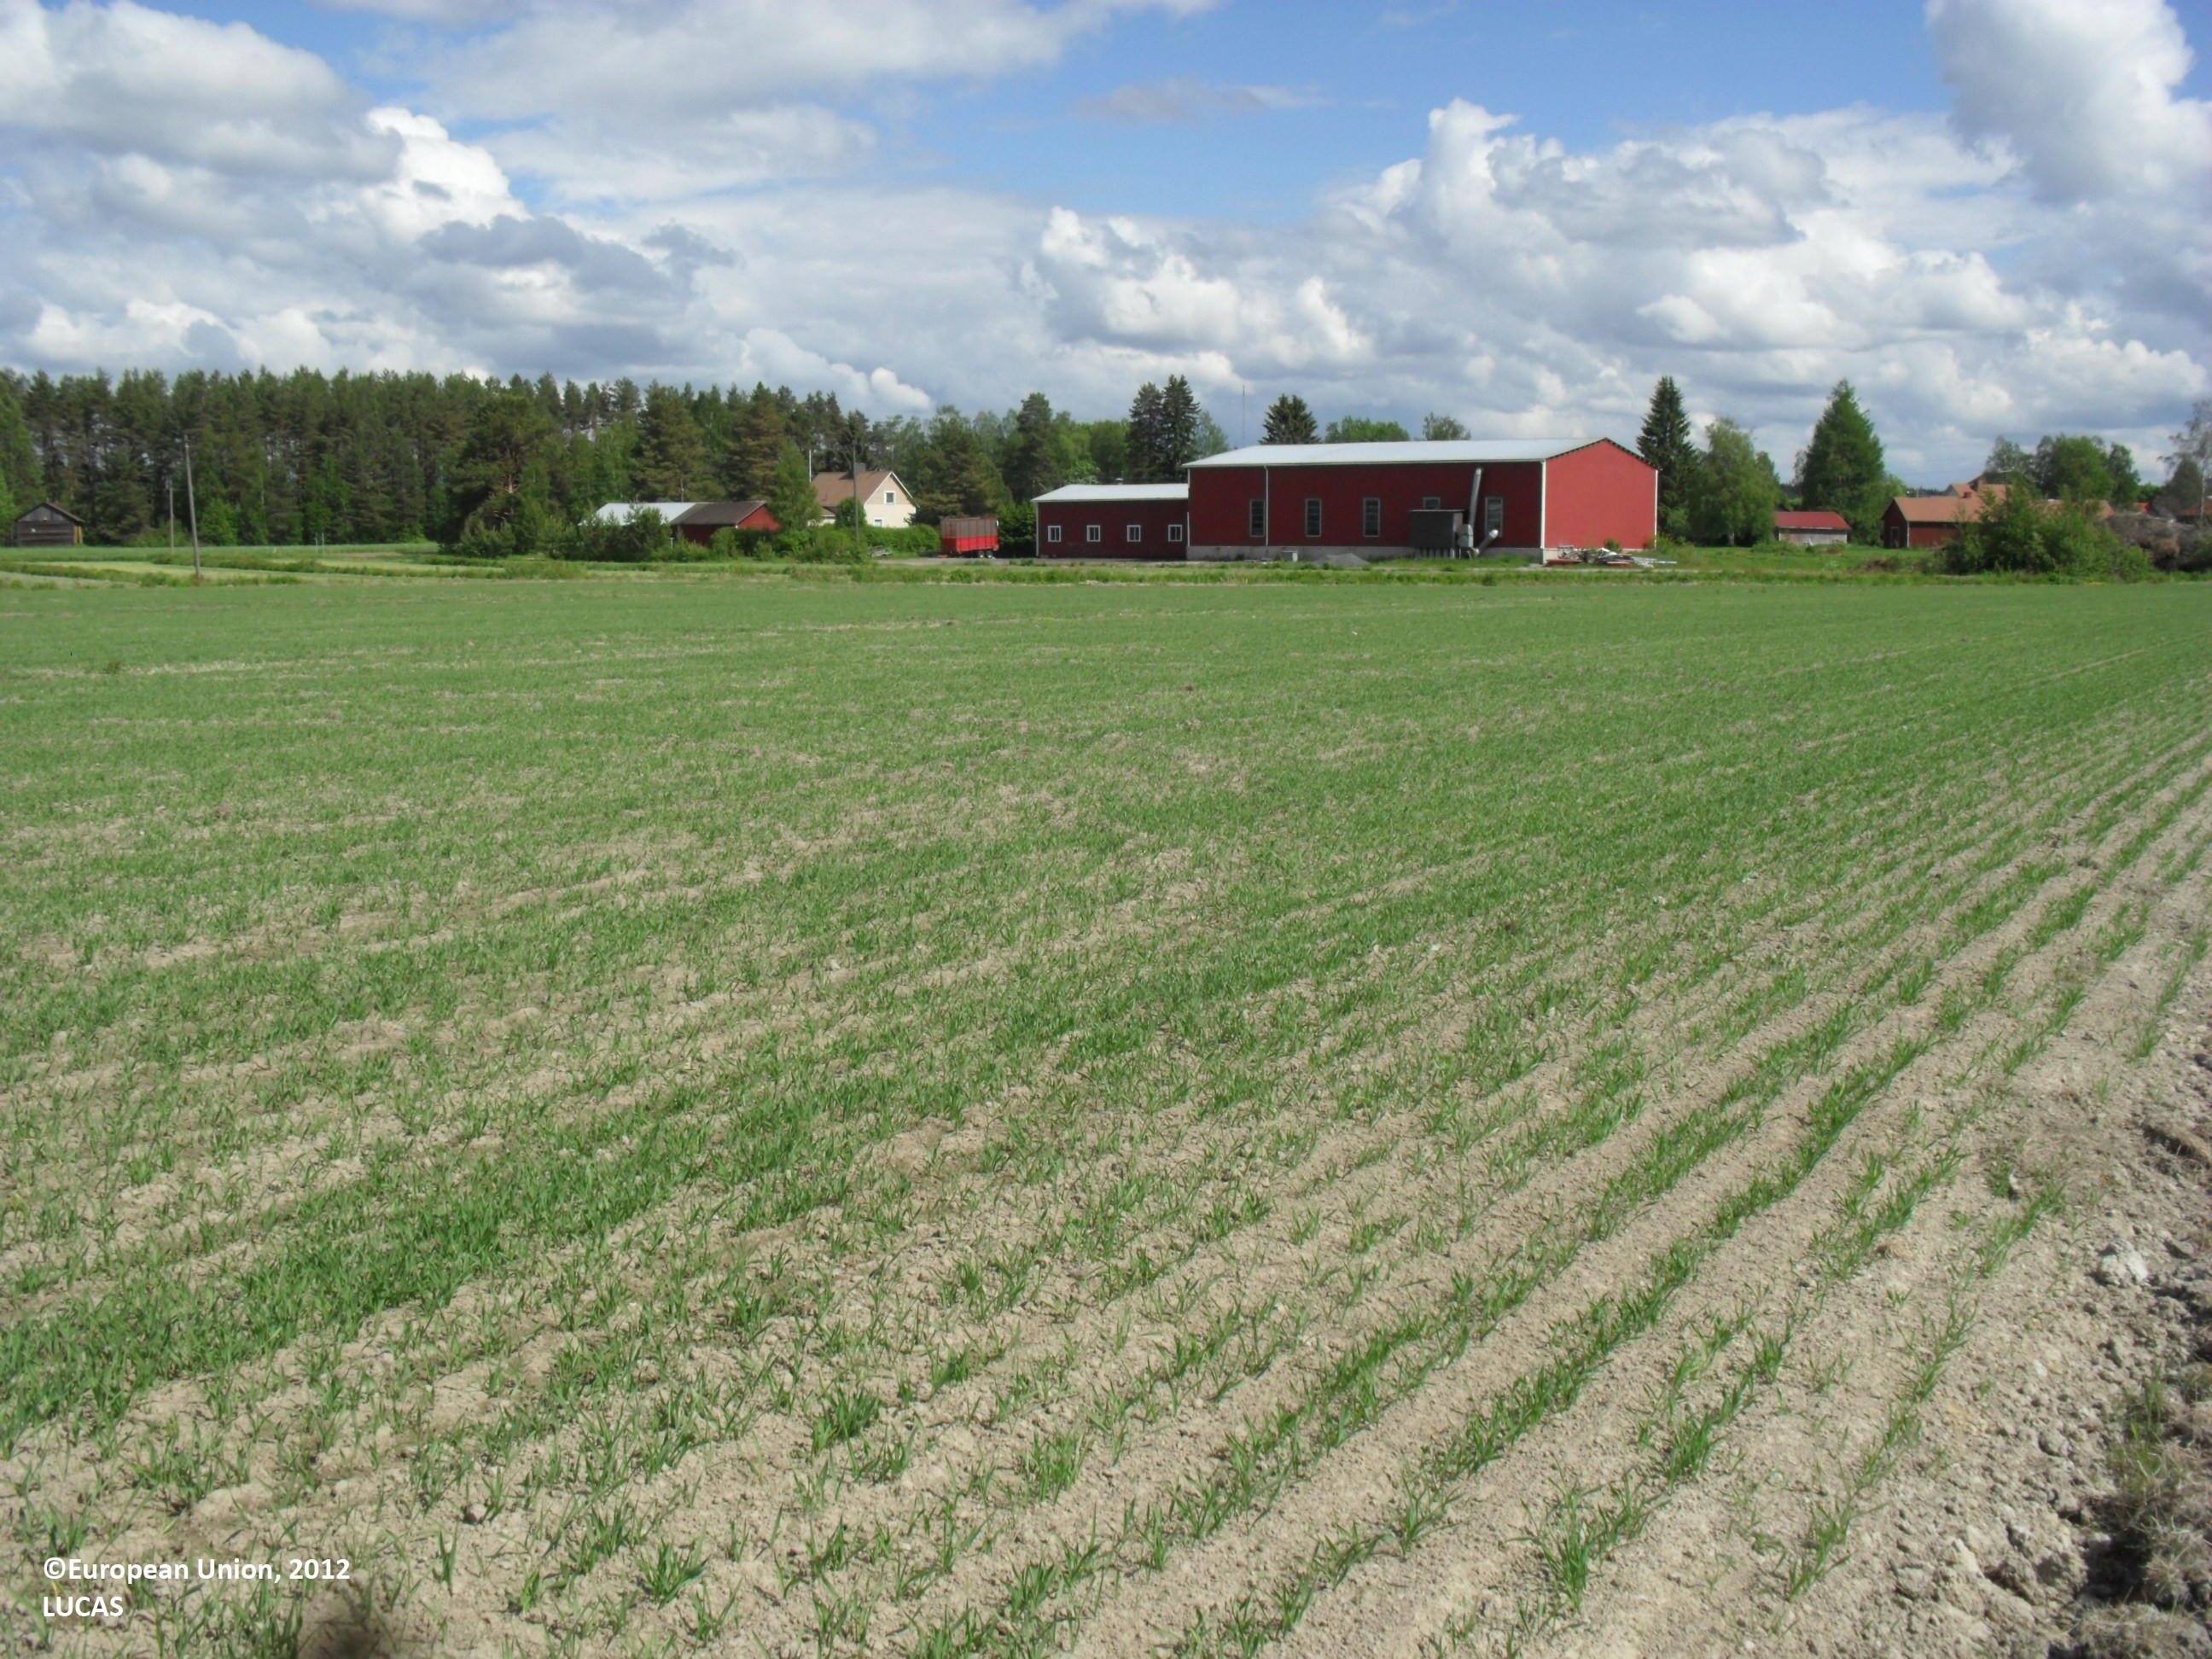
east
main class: Cropland
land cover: Barley
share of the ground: < 10 %
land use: Agriculture (excluding fallow land and kitchen gardens)
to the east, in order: Barley; Grass margins; Rivers and streams; Grass margins; Barley; Grass margins; Ditches and canals; Grass margins; Barley; Ditches and canals; Grass margins; Barley; Grass margins; Ditches and canals; Grass margins; Barley; Ditches and canals; Lines of trees; Paved roads, cycling and walking lanes; Grass margins; Ditches and canals; Artificial constructions in urban areas; Lines of trees; Paved roads, cycling and walking lanes; Ditches and canals; Temporary grasslands
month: June
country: FI
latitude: 62.8463
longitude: 23.4822
